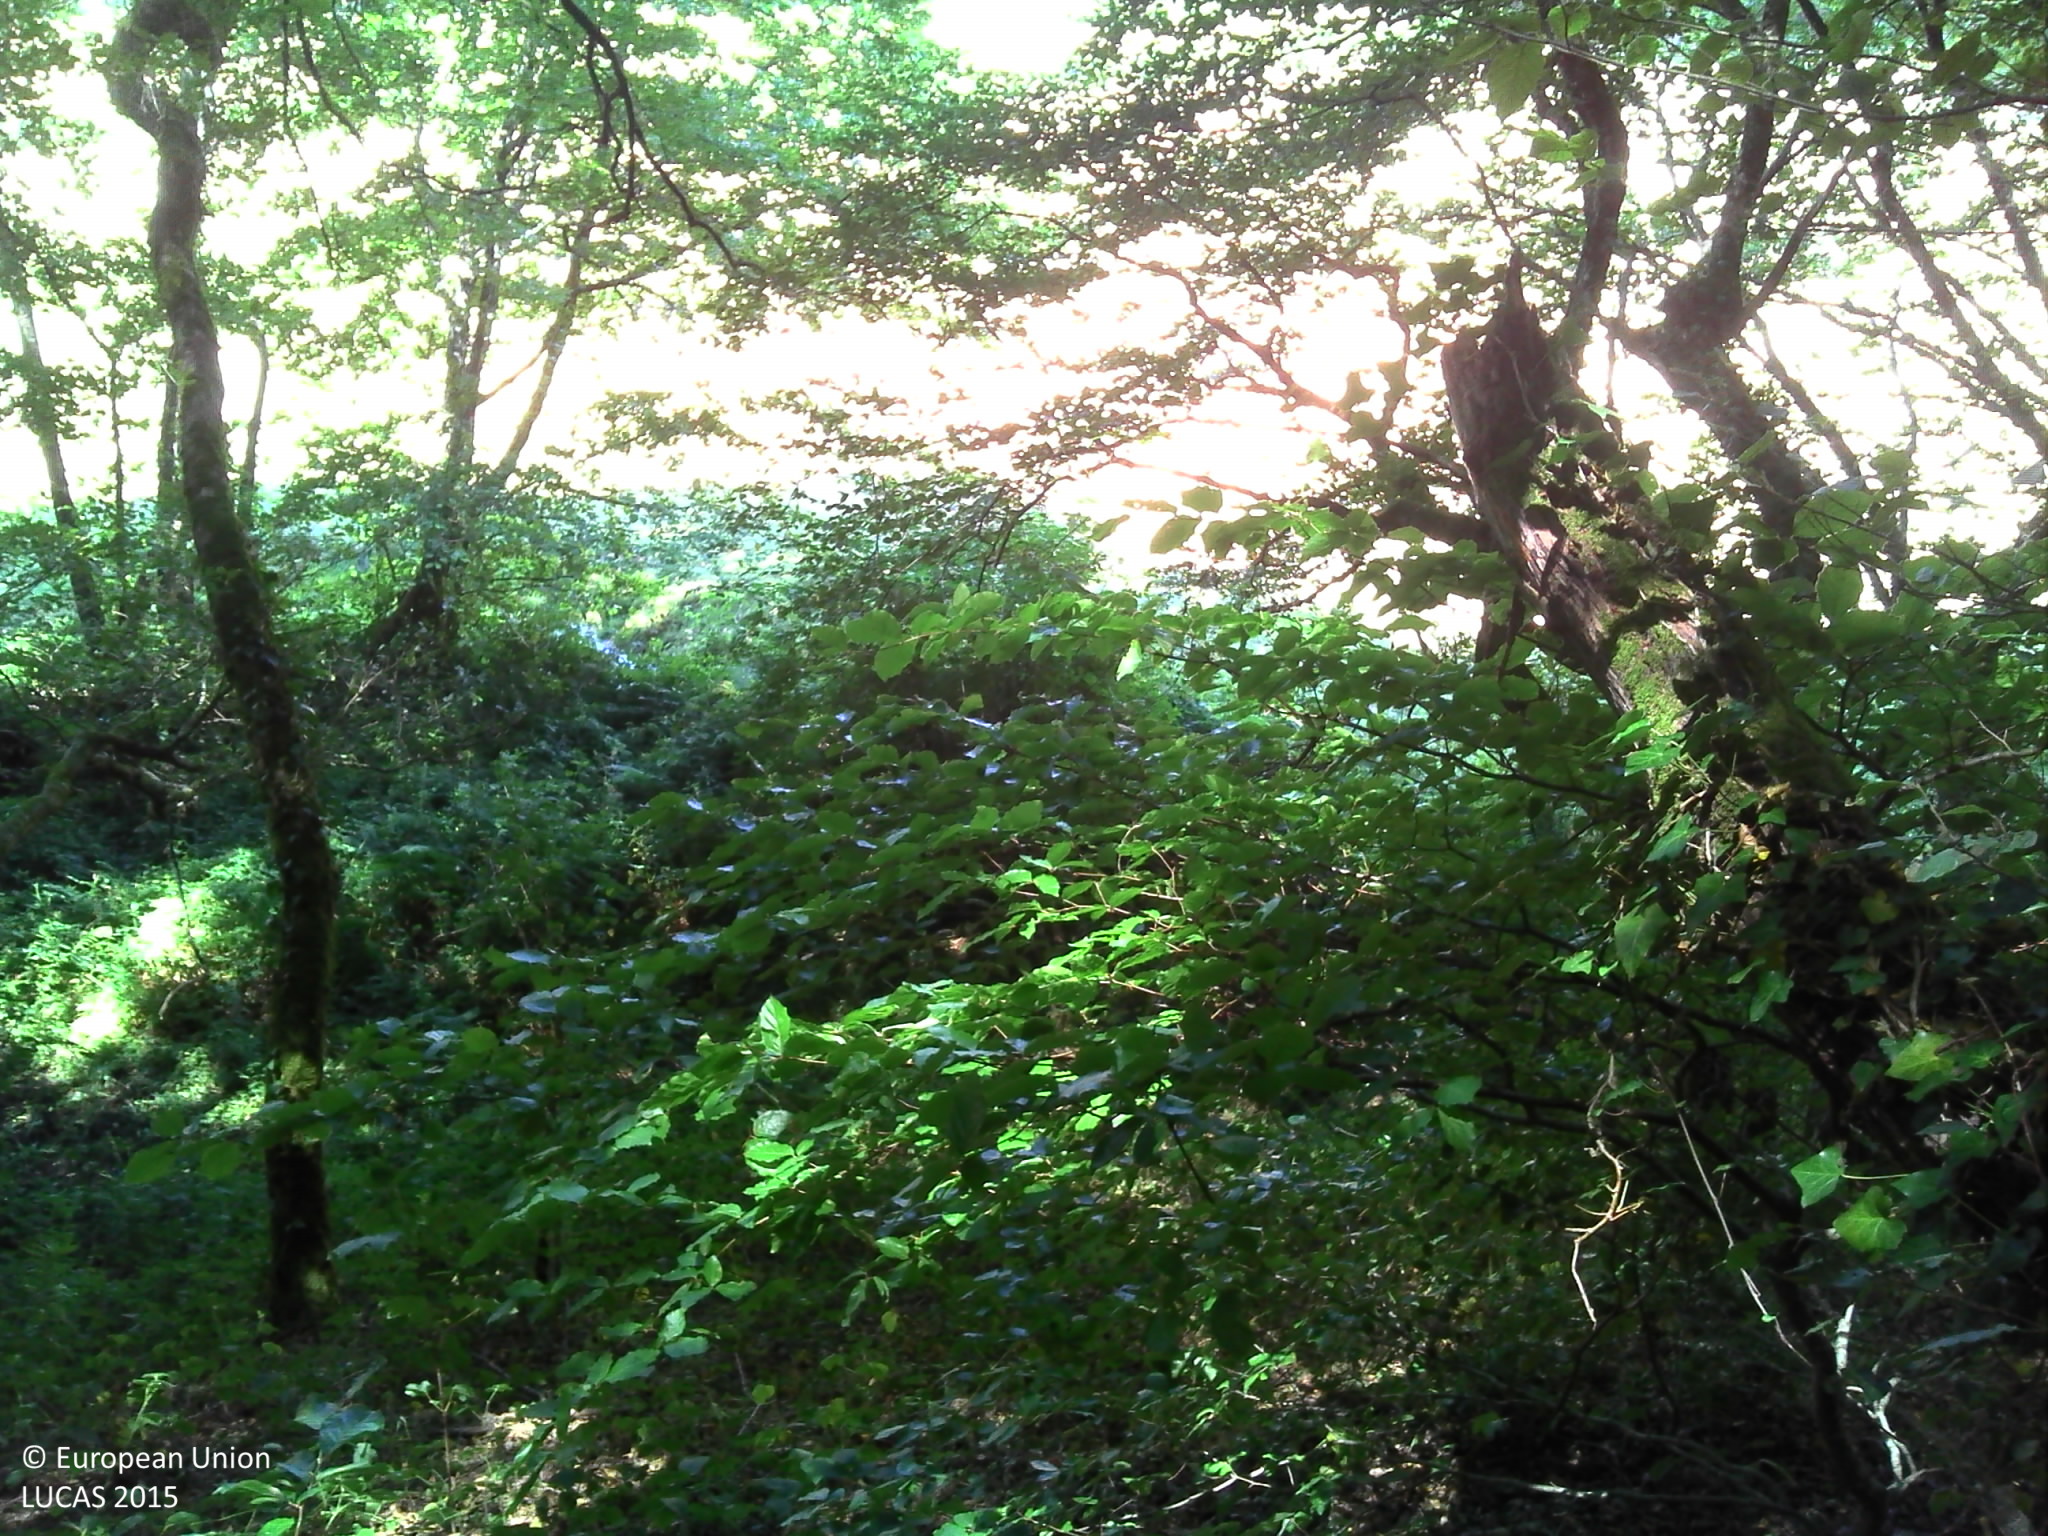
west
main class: Woodland
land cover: Broadleaved woodland
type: mesophytic deciduous forest
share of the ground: > 75 %
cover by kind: broadleaved forest trees 100 %
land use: Forestry
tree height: > 5 m
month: July
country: FR
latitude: 46.8168
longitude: 4.0361
